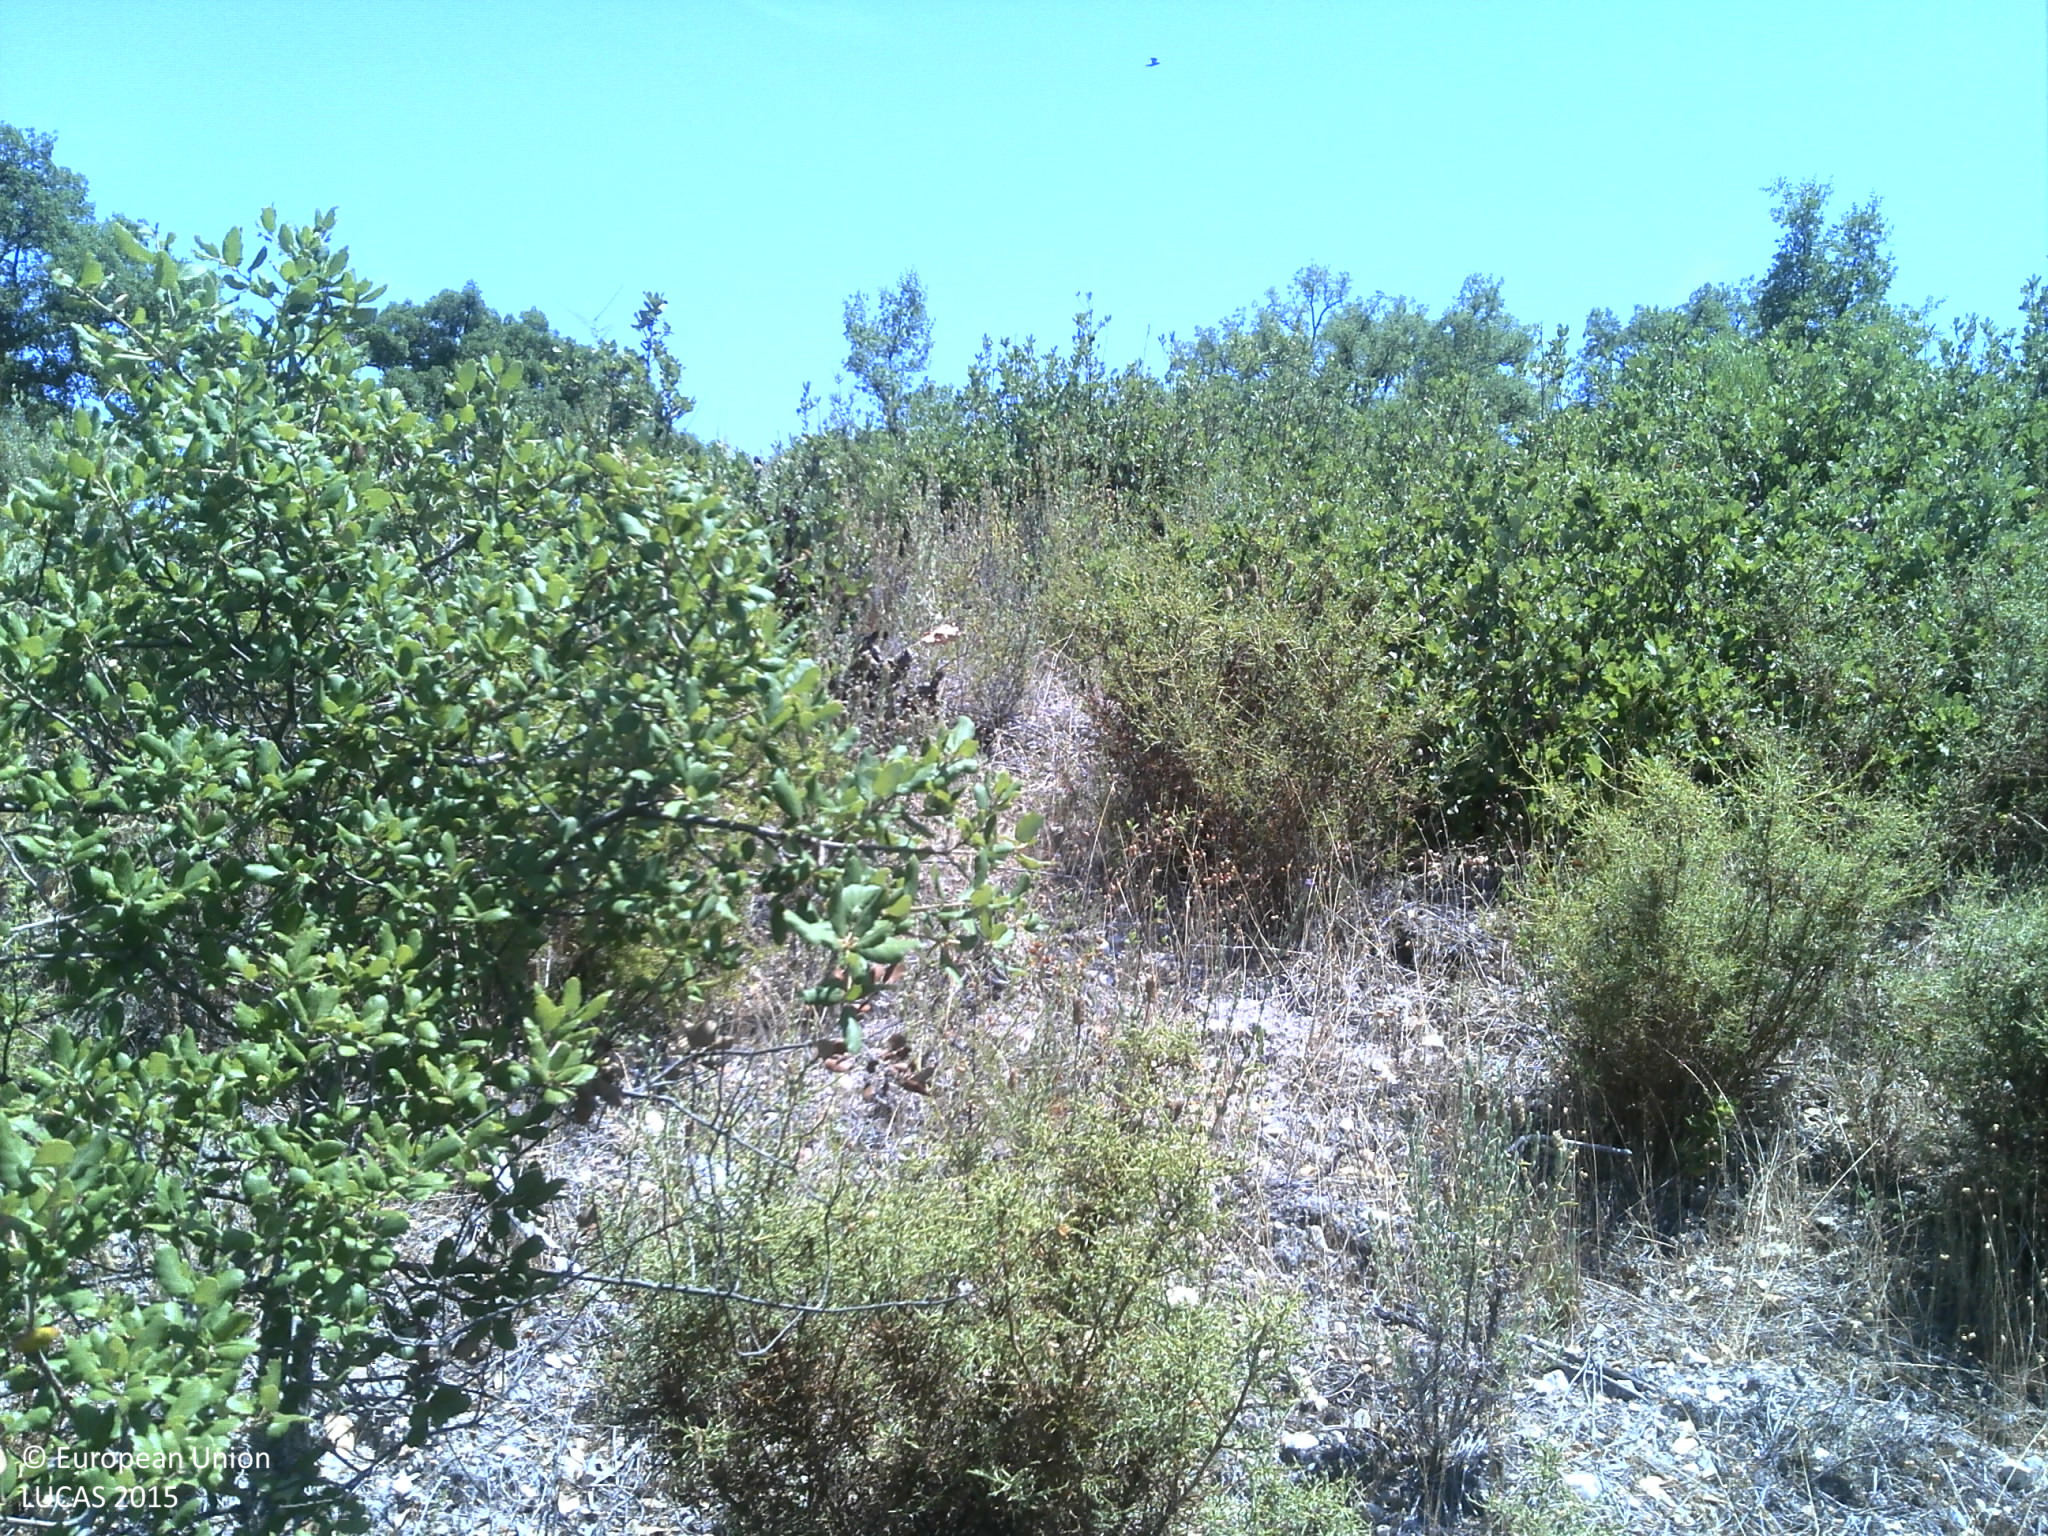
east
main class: Grassland
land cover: Grassland with sparse tree/shrub cover
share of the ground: 25 - 50 %
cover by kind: herbaceous plants 45 %, unconsolidated bare surface 40 %, shrubs 10 %, broadleaved forest trees 5 %
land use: Forestry
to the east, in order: Grassland with sparse tree/shrub cover; Broadleaved woodland; Tracks; Broadleaved woodland; Tracks; Broadleaved woodland; Rivers and streams; Broadleaved woodland; Tracks; Broadleaved woodland
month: July
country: PT
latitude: 39.2176
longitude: -8.2801
